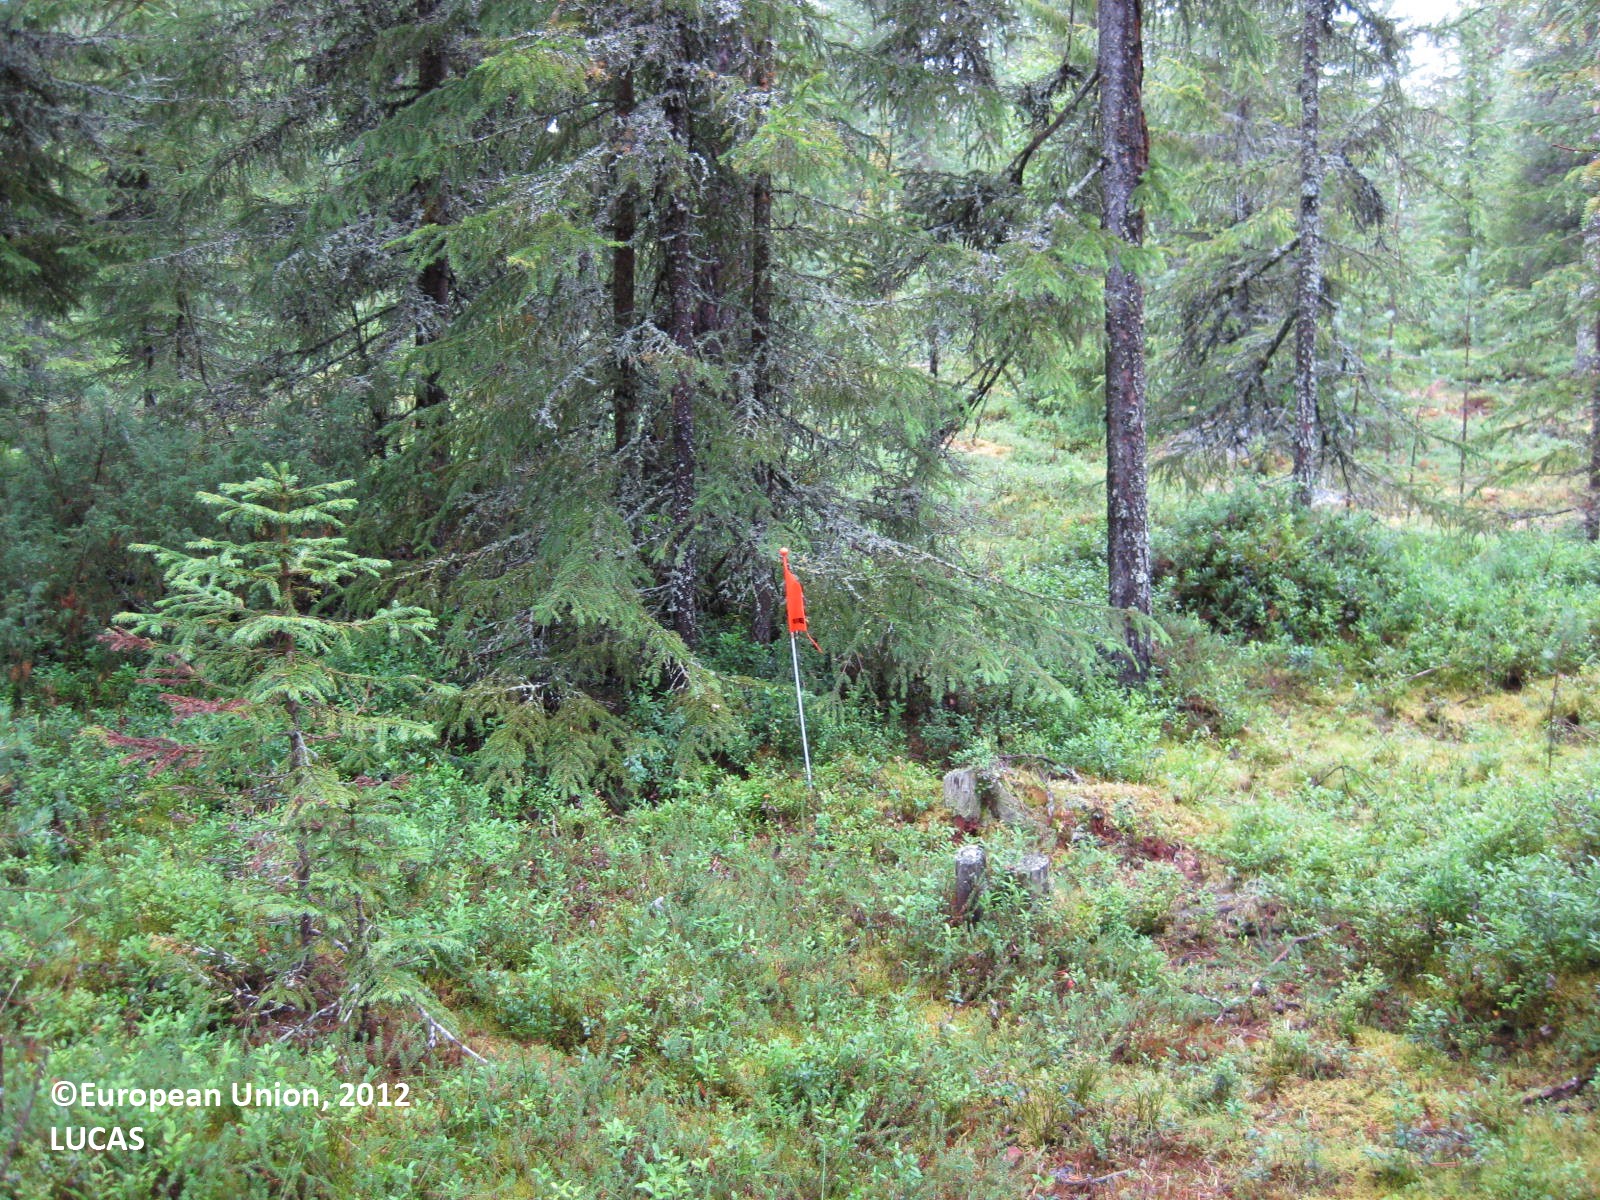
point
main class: Woodland
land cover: Other coniferous woodland
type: boreal forest
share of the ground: 50 - 75 %
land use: Forestry
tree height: > 5 m
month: August
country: FI
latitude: 65.8291
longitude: 28.0676
